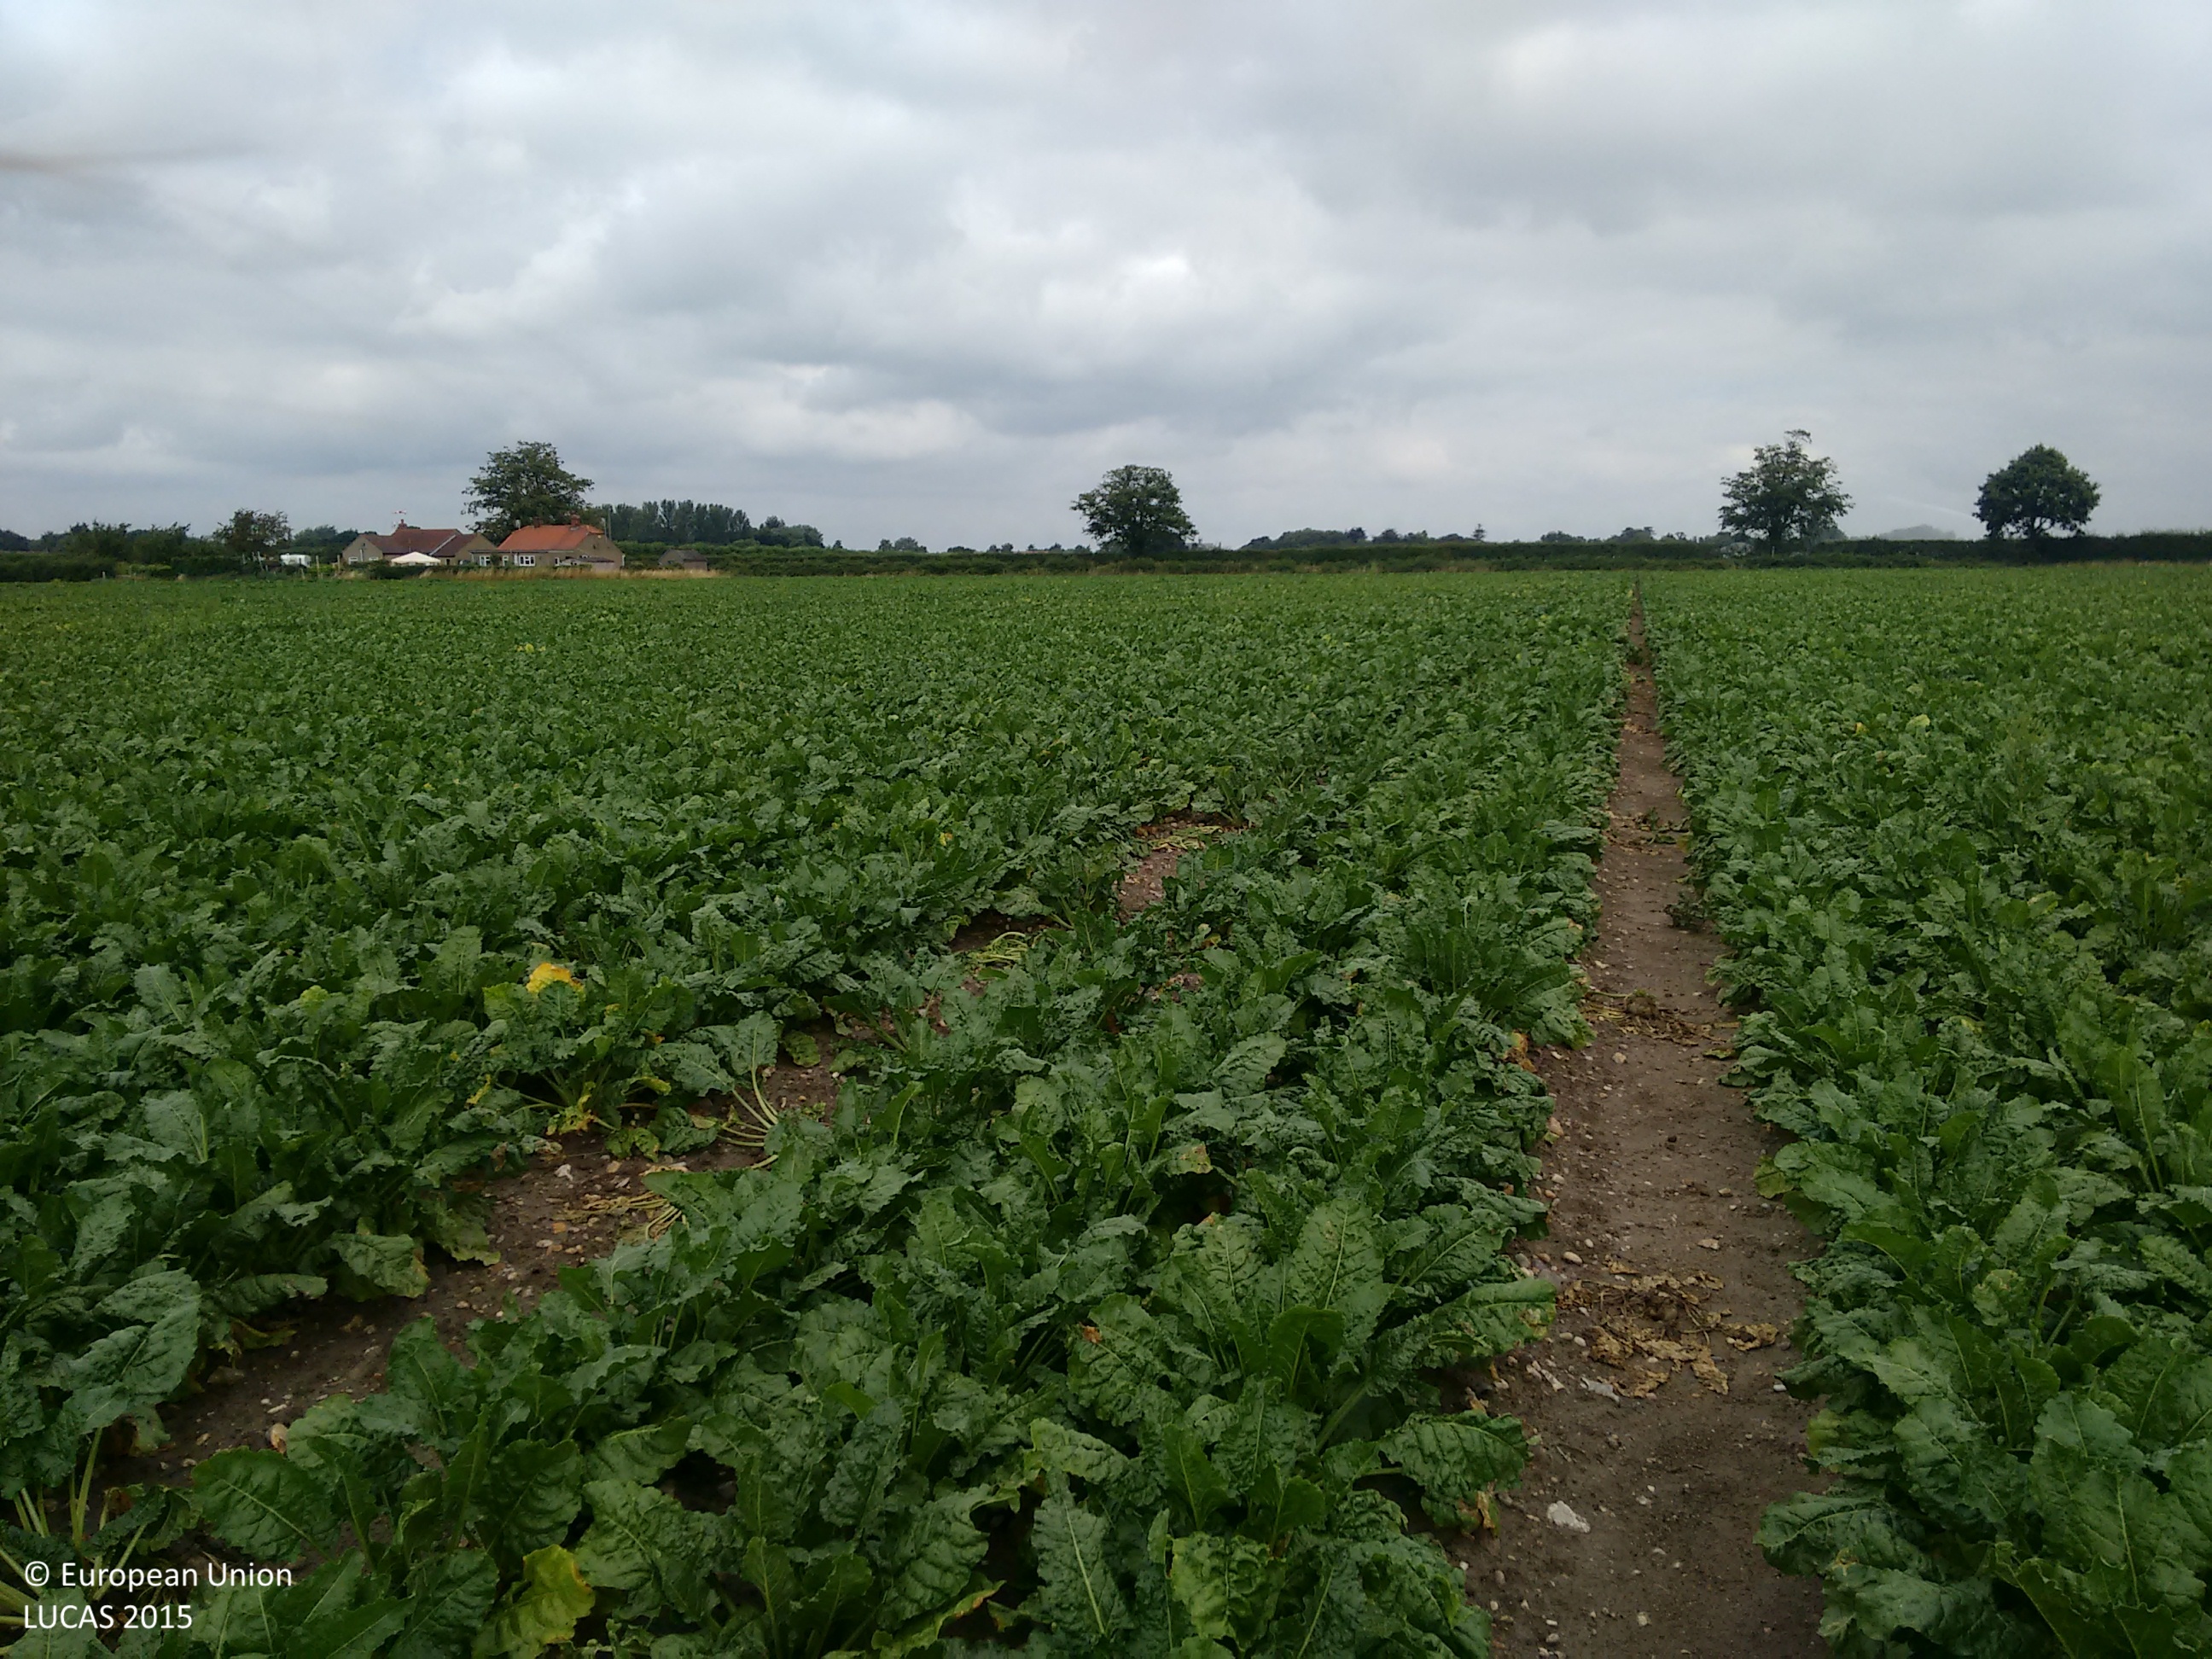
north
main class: Cropland
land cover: Sugar beet
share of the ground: > 75 %
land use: Agriculture (excluding fallow land and kitchen gardens)
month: August
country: GB
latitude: 51.9402
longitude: 0.9429
